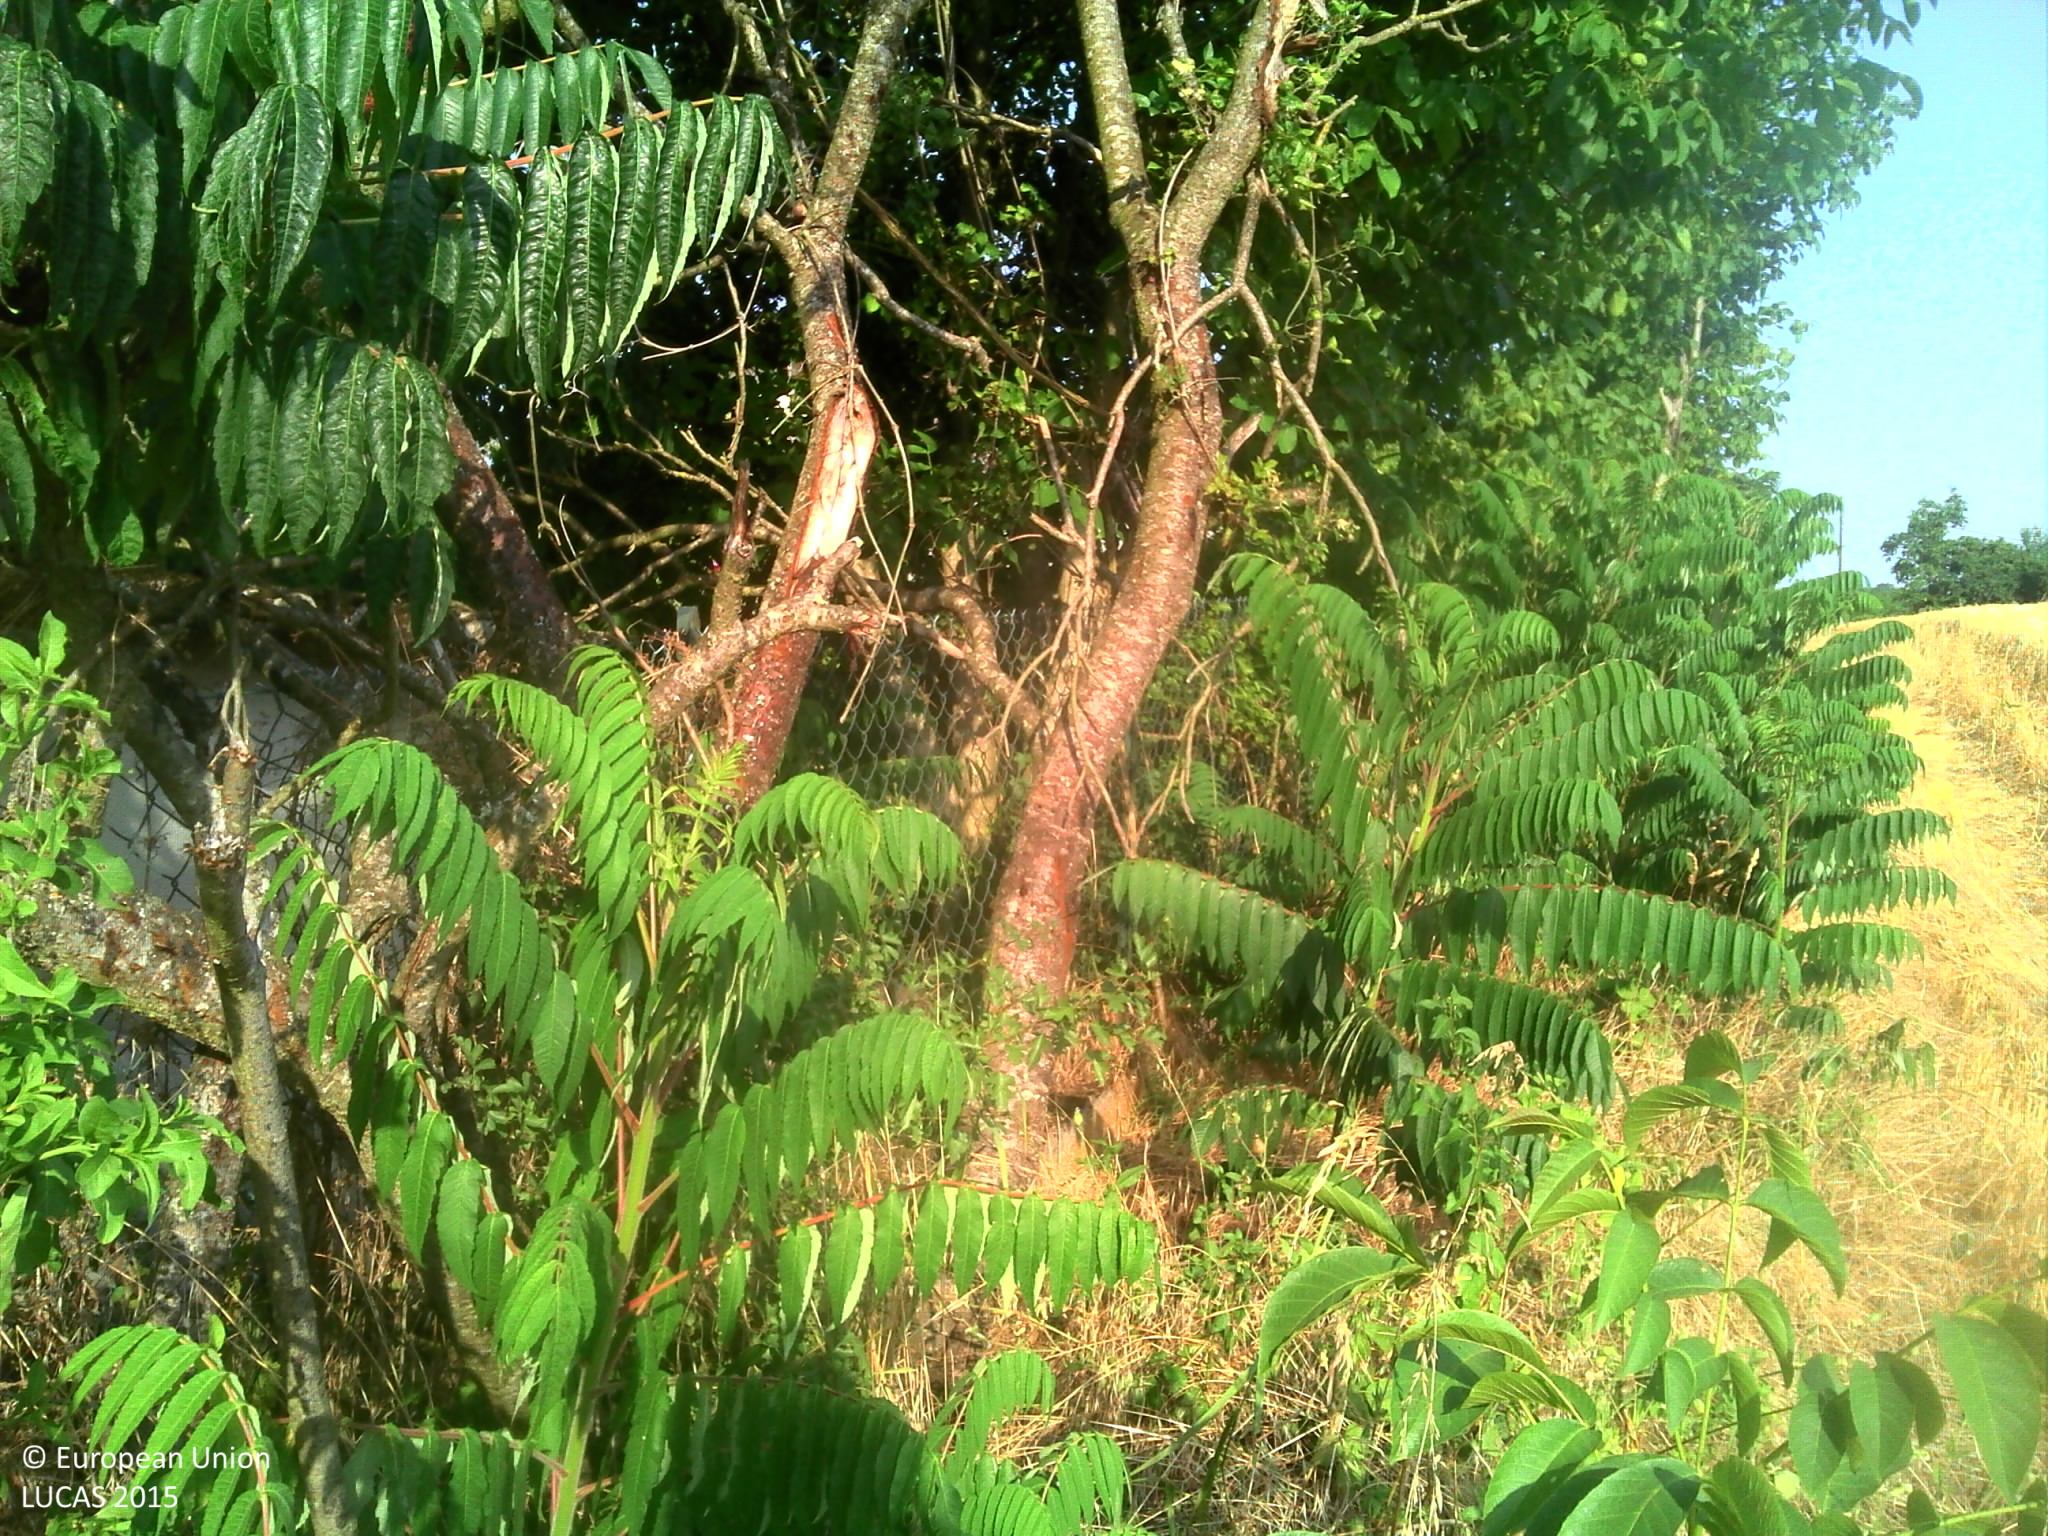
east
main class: Grassland
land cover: Grassland with sparse tree/shrub cover
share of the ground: > 75 %
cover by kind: herbaceous plants 95 %, coniferous forest trees 5 %
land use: Residential
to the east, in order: Grassland with sparse tree/shrub cover; Artificial constructions in urban areas
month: July
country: FR
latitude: 45.6476
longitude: 5.1924
